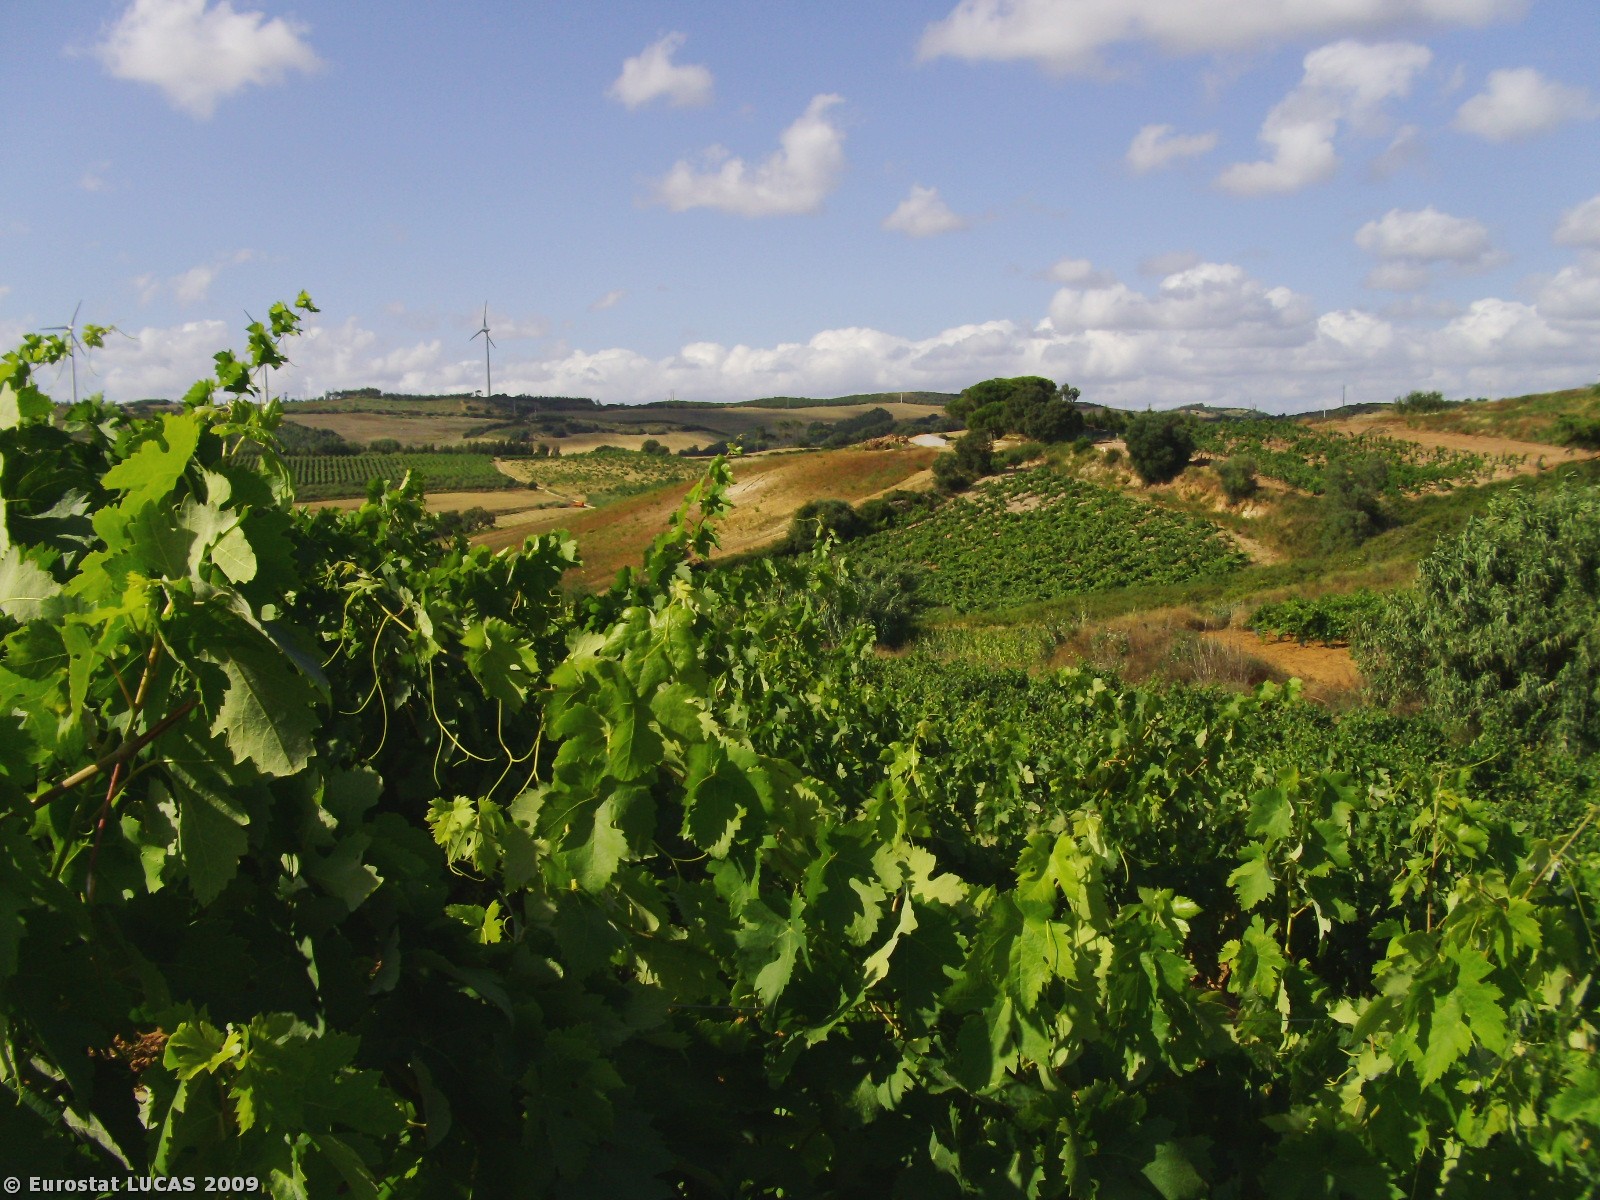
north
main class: Cropland
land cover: Vineyards
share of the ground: 50 - 75 %
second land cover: Bare land
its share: 25 - 50 %
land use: Agriculture (excluding fallow land and kitchen gardens)
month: July
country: PT
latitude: 39.0444
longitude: -9.2531
